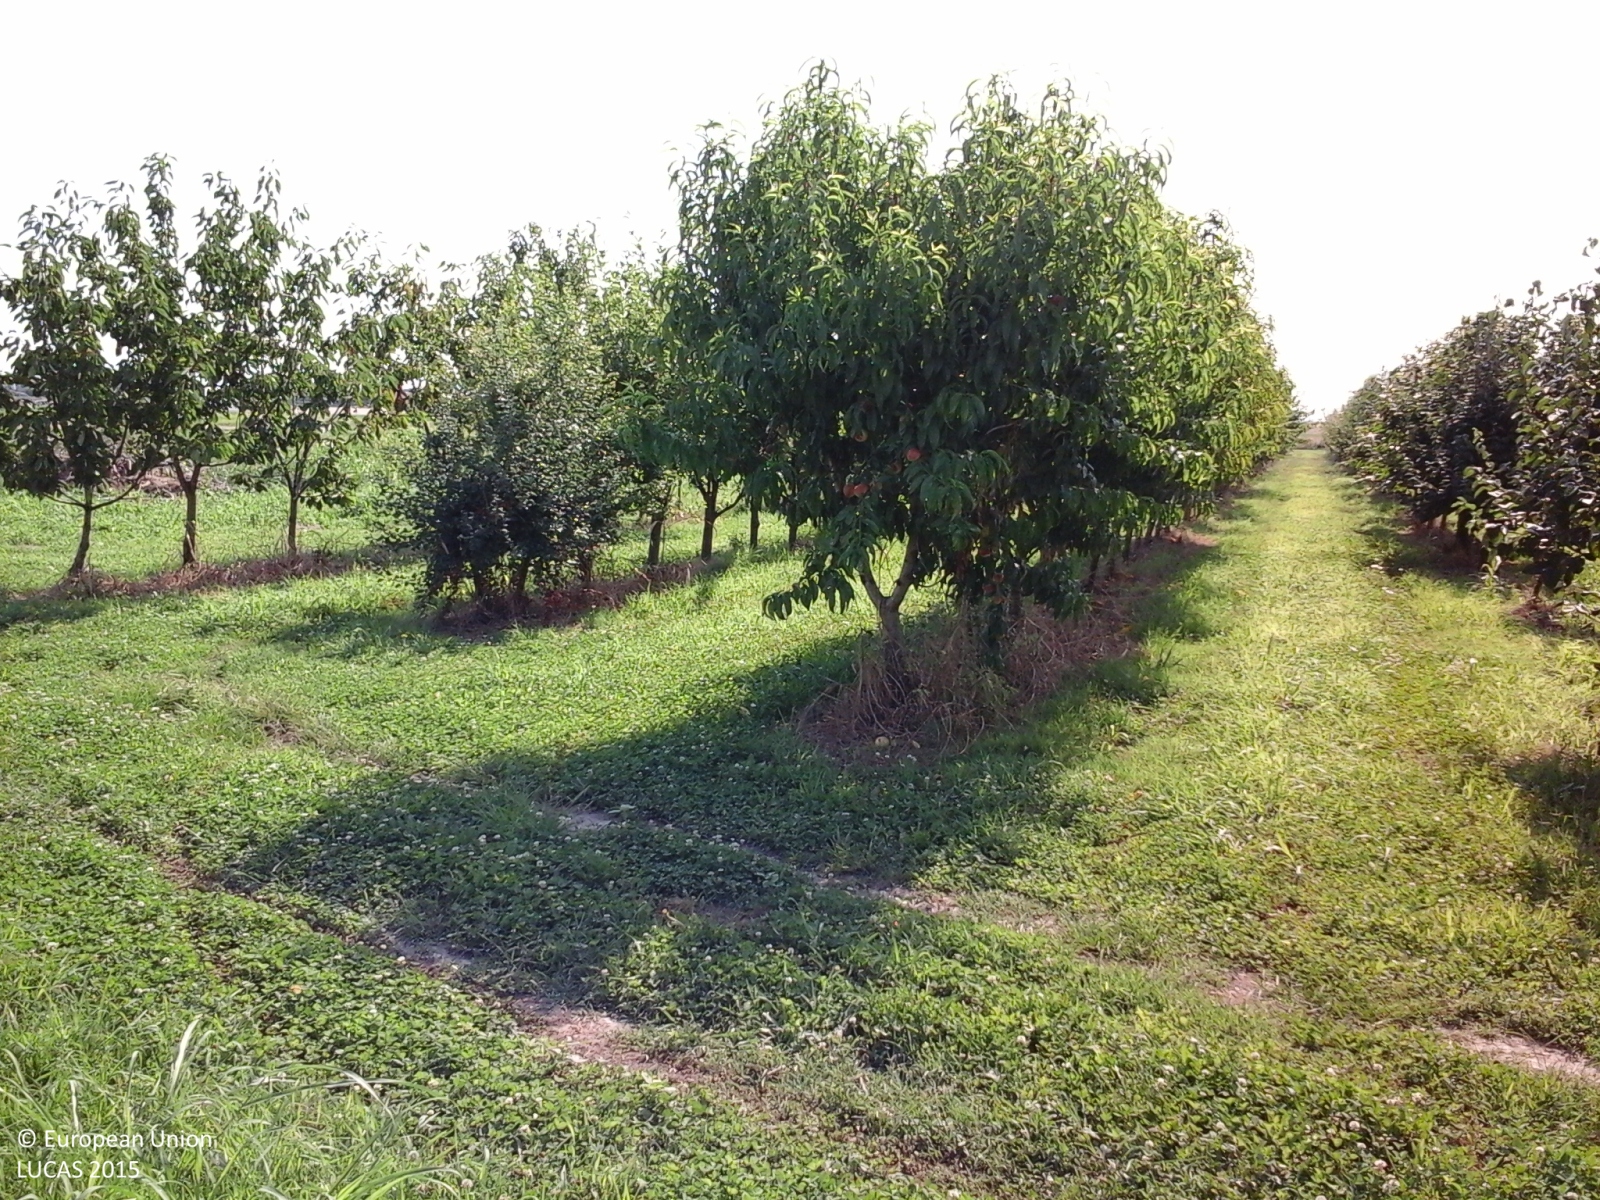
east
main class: Cropland
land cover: Soya
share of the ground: > 75 %
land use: Agriculture (excluding fallow land and kitchen gardens)
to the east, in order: Soya; Ditches and canals; Tracks; Other fruit trees and berries; Spontaneously vegetated surfaces; Grass margins; Ditches and canals; Grass margins; Common wheat; Grass margins; Ditches and canals; Grass margins; Common wheat
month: July
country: IT
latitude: 45.2111
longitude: 12.1990
